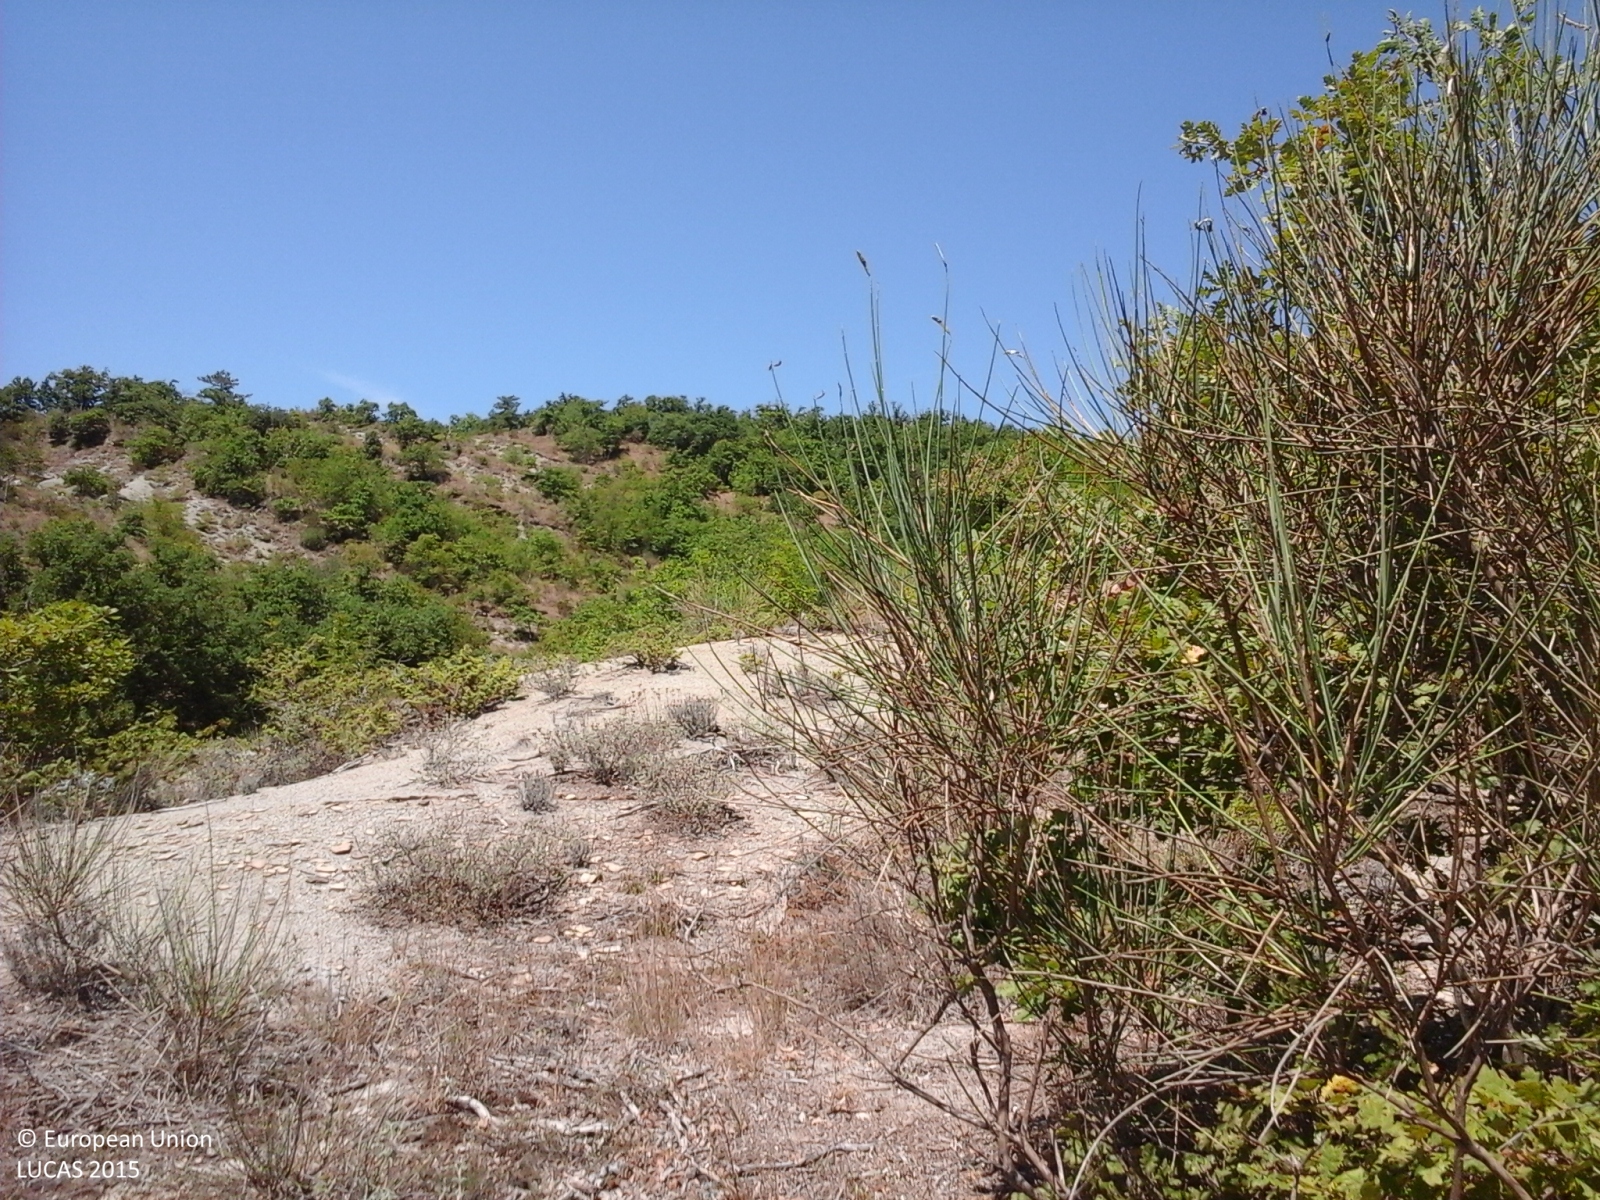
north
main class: Shrubland
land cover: Shrubland with sparse tree cover
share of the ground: > 75 %
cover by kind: shrubs 95 %, broadleaved forest trees 5 %
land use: Forestry
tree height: > 5 m
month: August
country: IT
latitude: 43.4772
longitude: 12.2810
